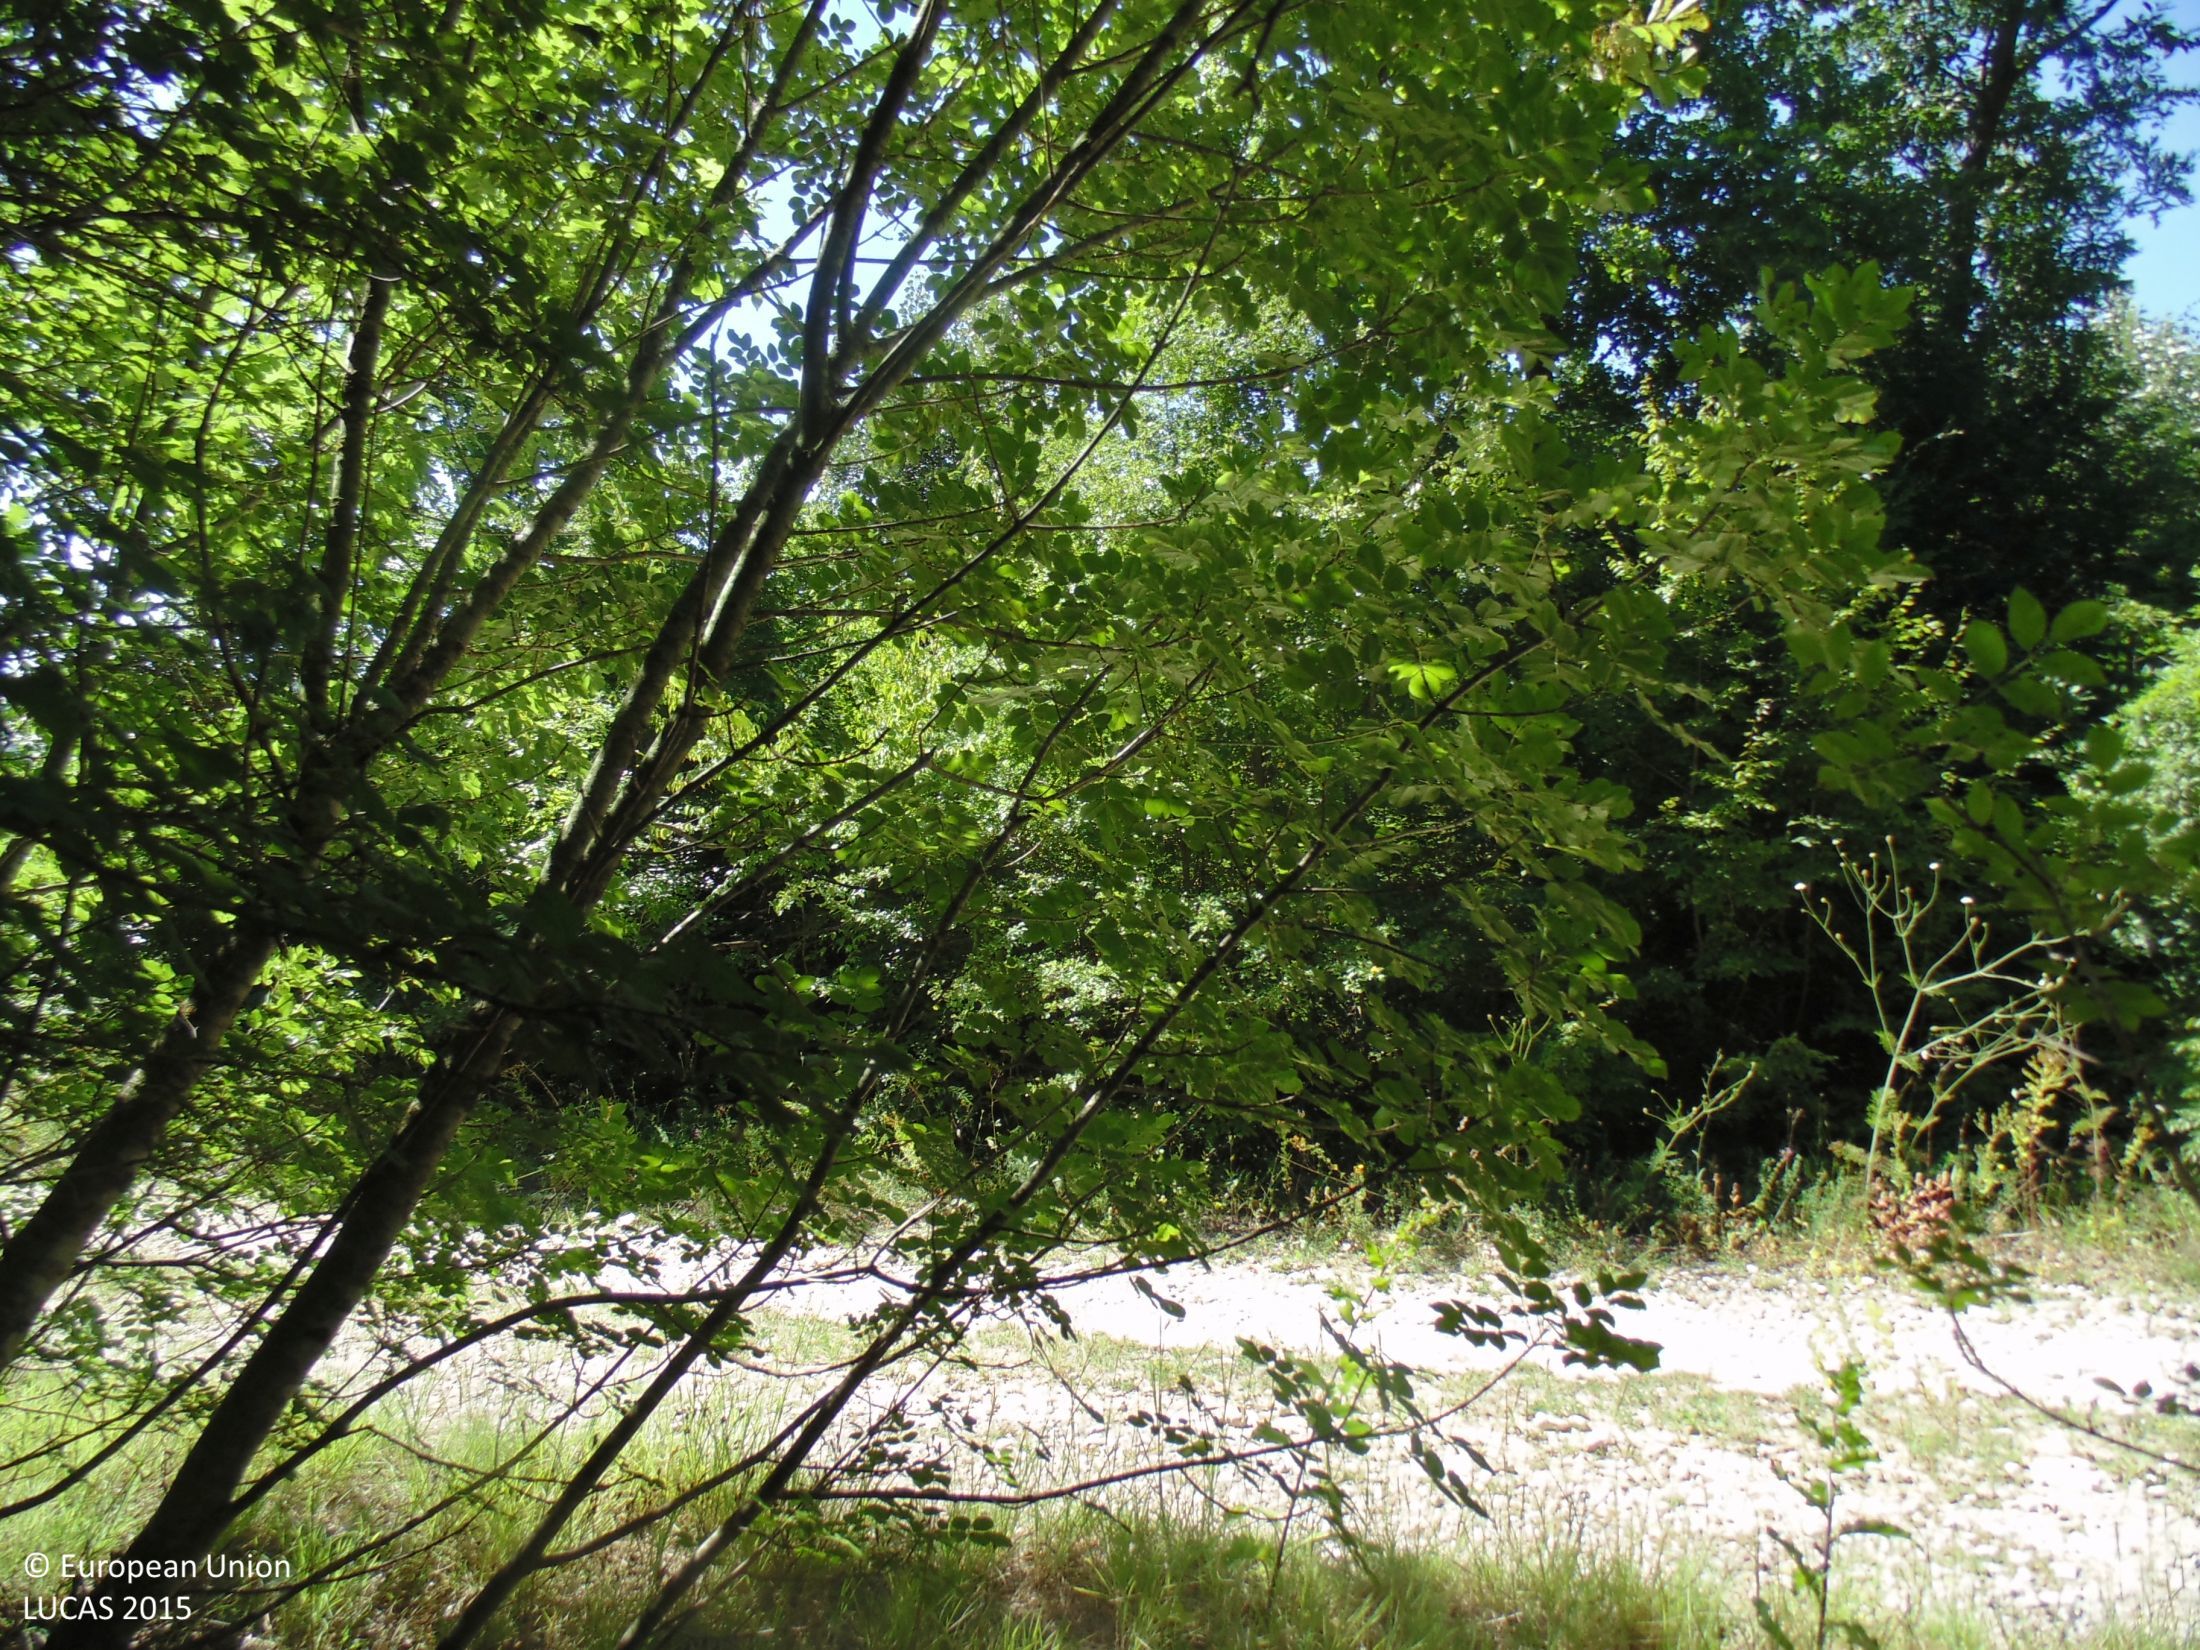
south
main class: Woodland
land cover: Broadleaved woodland
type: mesophytic deciduous forest
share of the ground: > 75 %
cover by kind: broadleaved forest trees 90 %, shrubs 5 %, consolidated bare surface 5 %
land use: Forestry
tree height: > 5 m
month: July
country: BG
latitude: 43.4168
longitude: 27.9398
